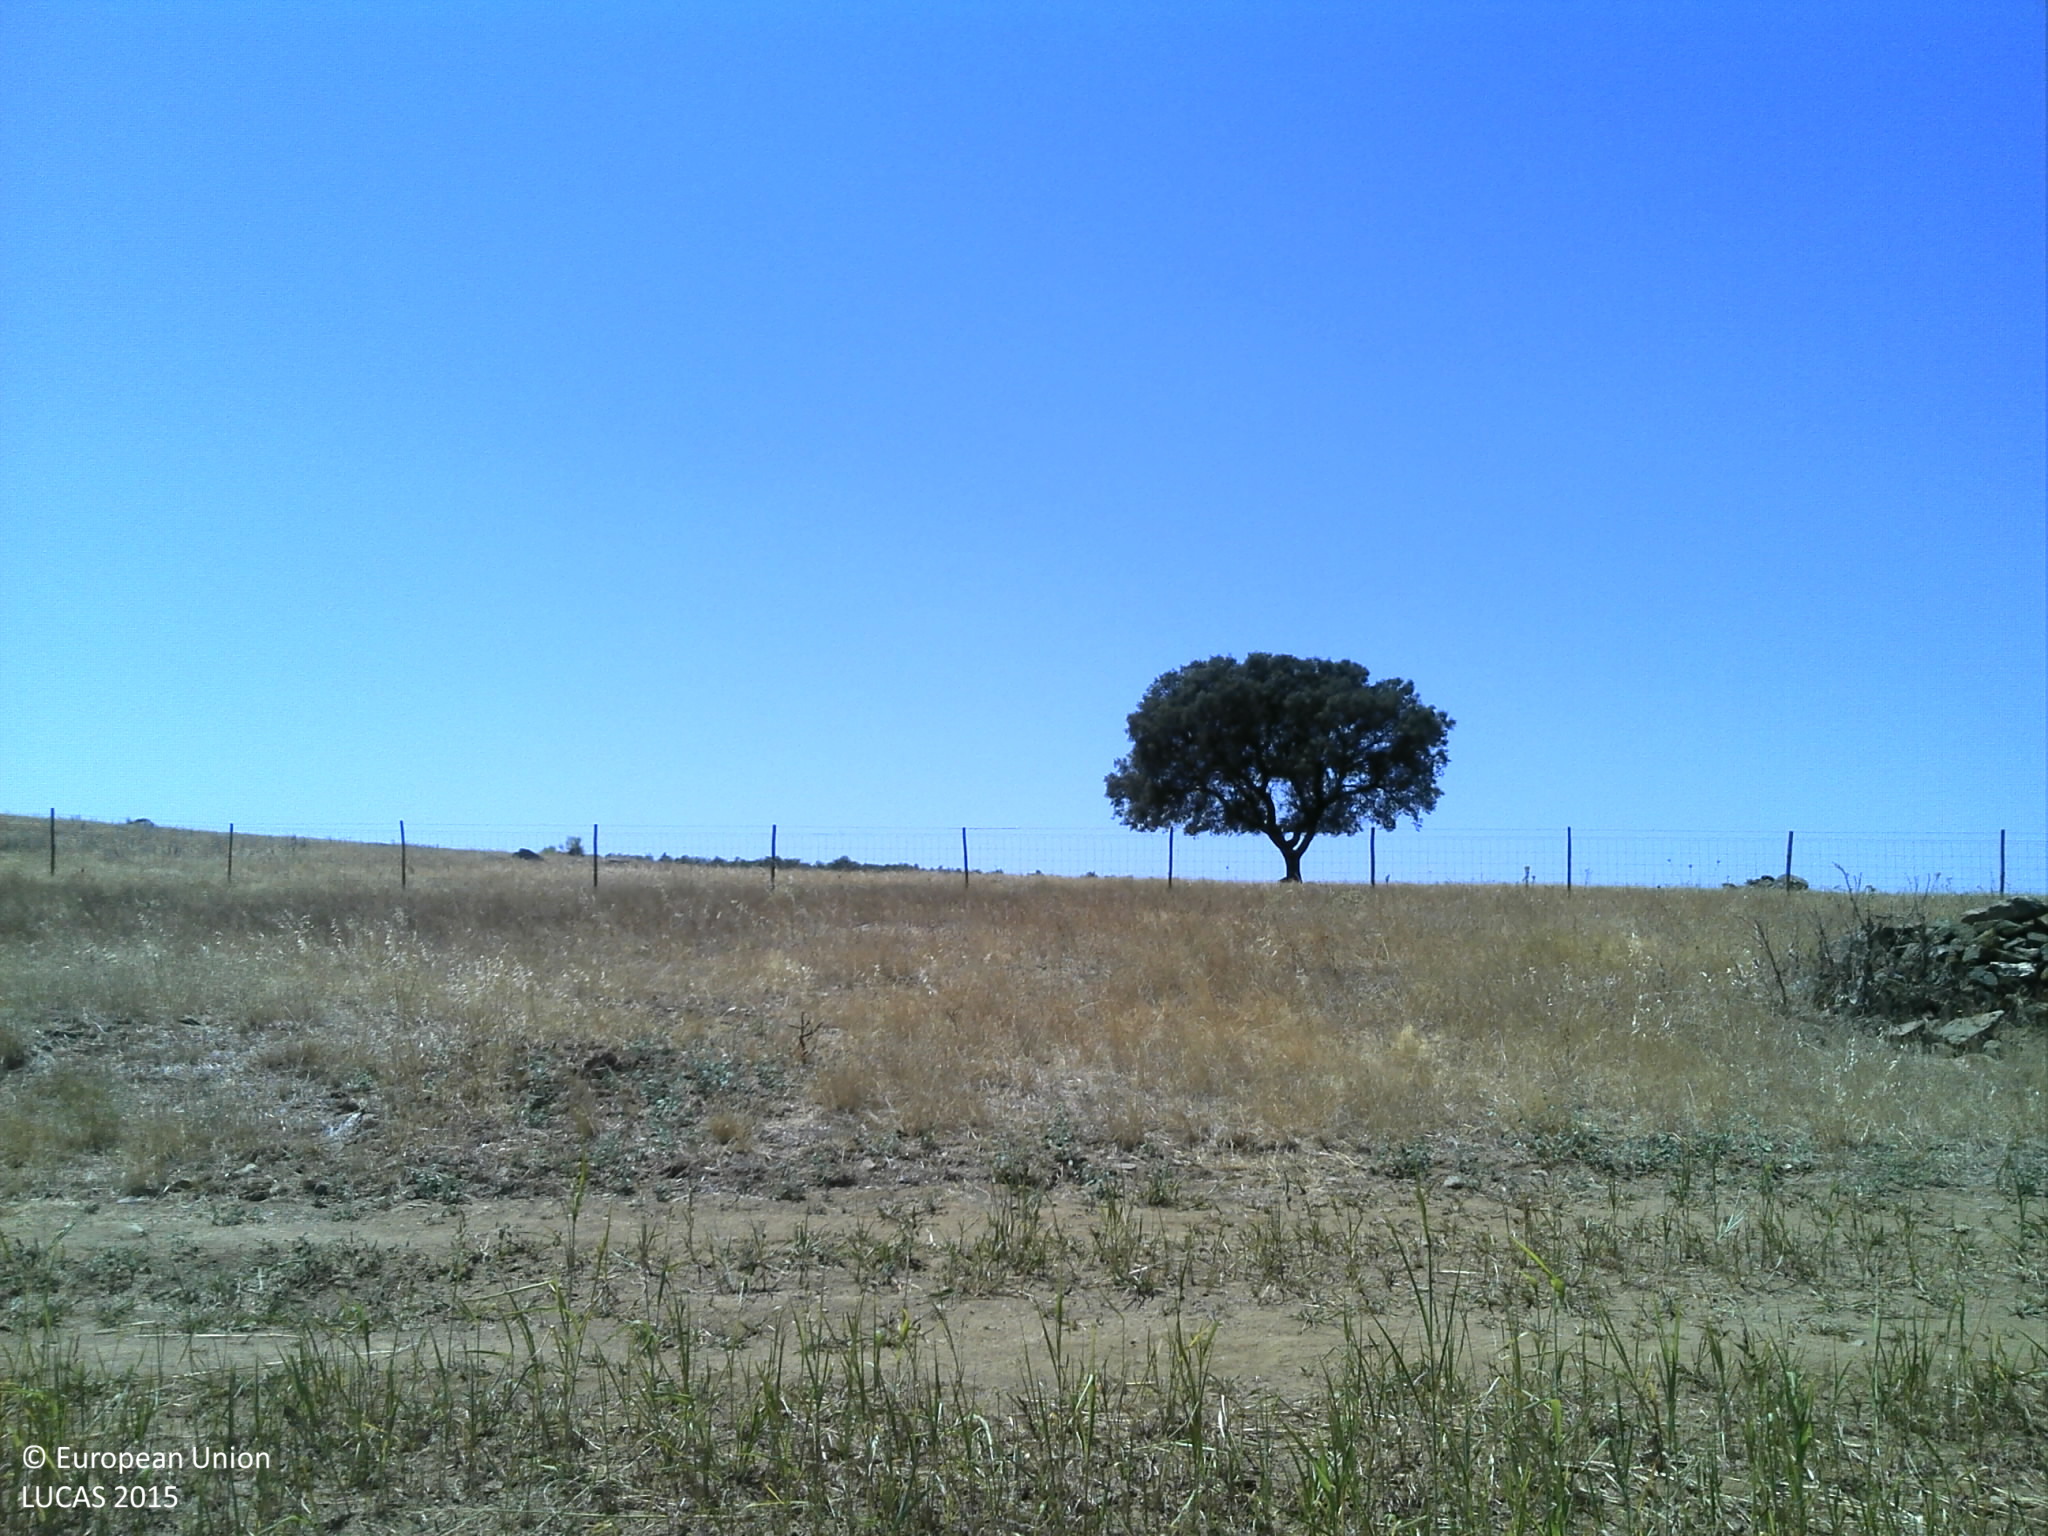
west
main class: Cropland
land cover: Other cereals
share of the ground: 10 - 25 %
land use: Agriculture (excluding fallow land and kitchen gardens)
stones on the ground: < 10 %
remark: Harvested field
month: July
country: PT
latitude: 38.9084
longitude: -7.3653
